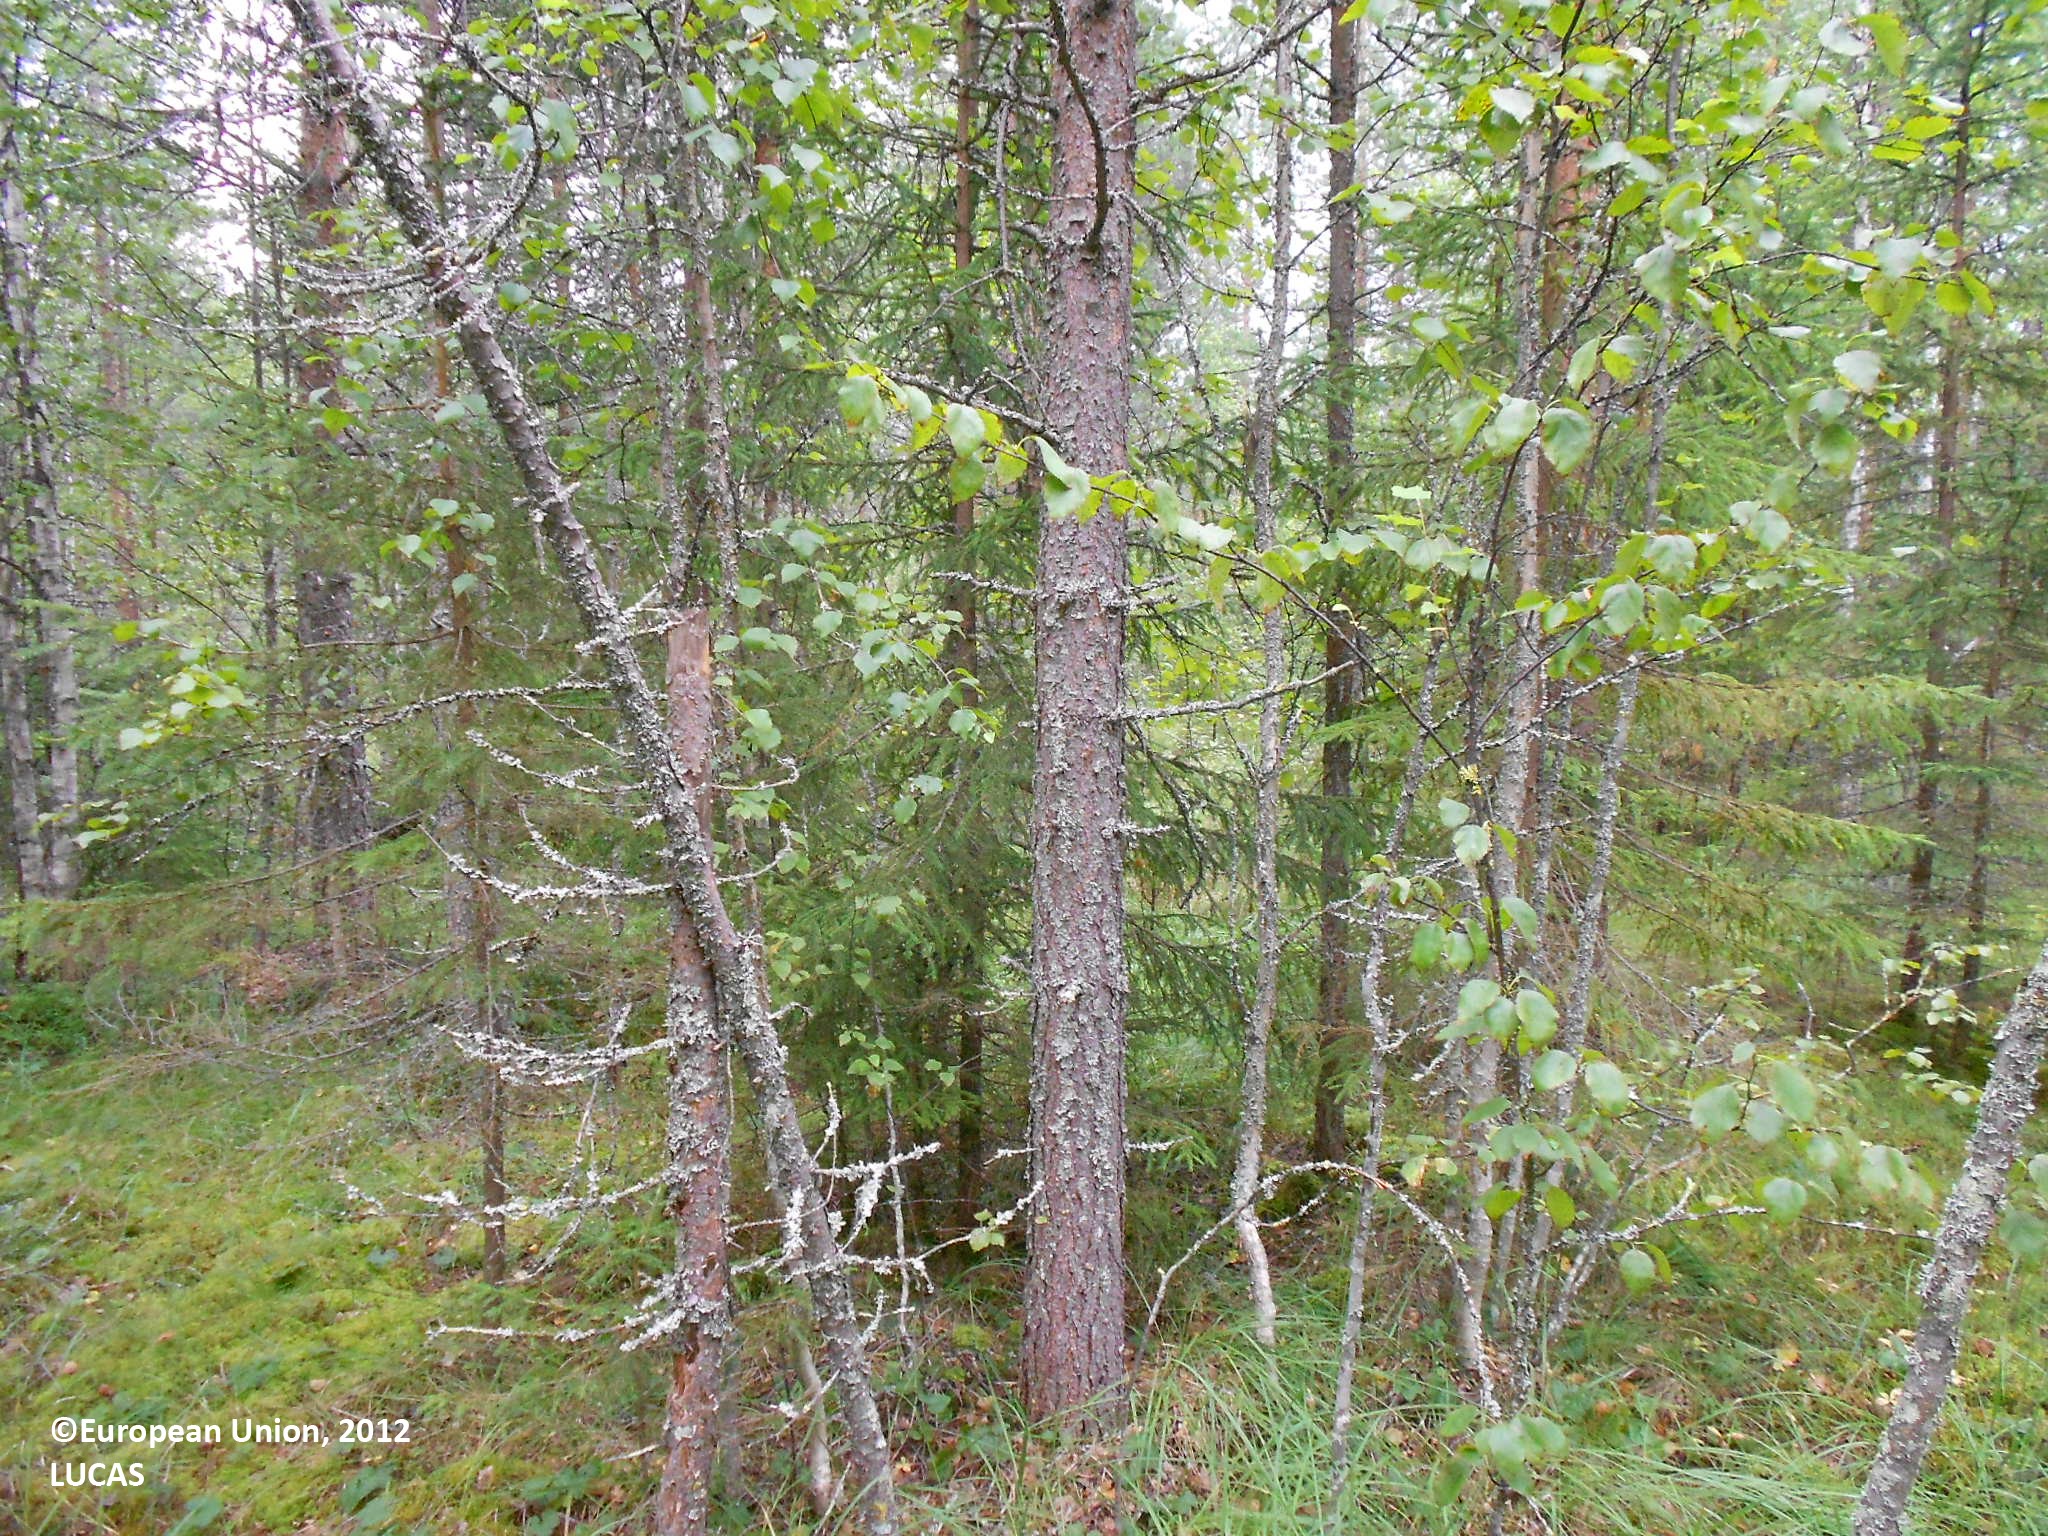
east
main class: Woodland
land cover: Pine dominated coniferous woodland
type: boreal forest
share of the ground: 50 - 75 %
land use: Forestry
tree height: > 5 m
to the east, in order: Pine dominated coniferous woodland; Ditches and canals; Pine dominated coniferous woodland; Ditches and canals; Pine dominated coniferous woodland; Ditches and canals; Pine dominated coniferous woodland; Ditches and canals; Pine dominated coniferous woodland
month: August
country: FI
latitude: 63.4263
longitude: 28.9402
